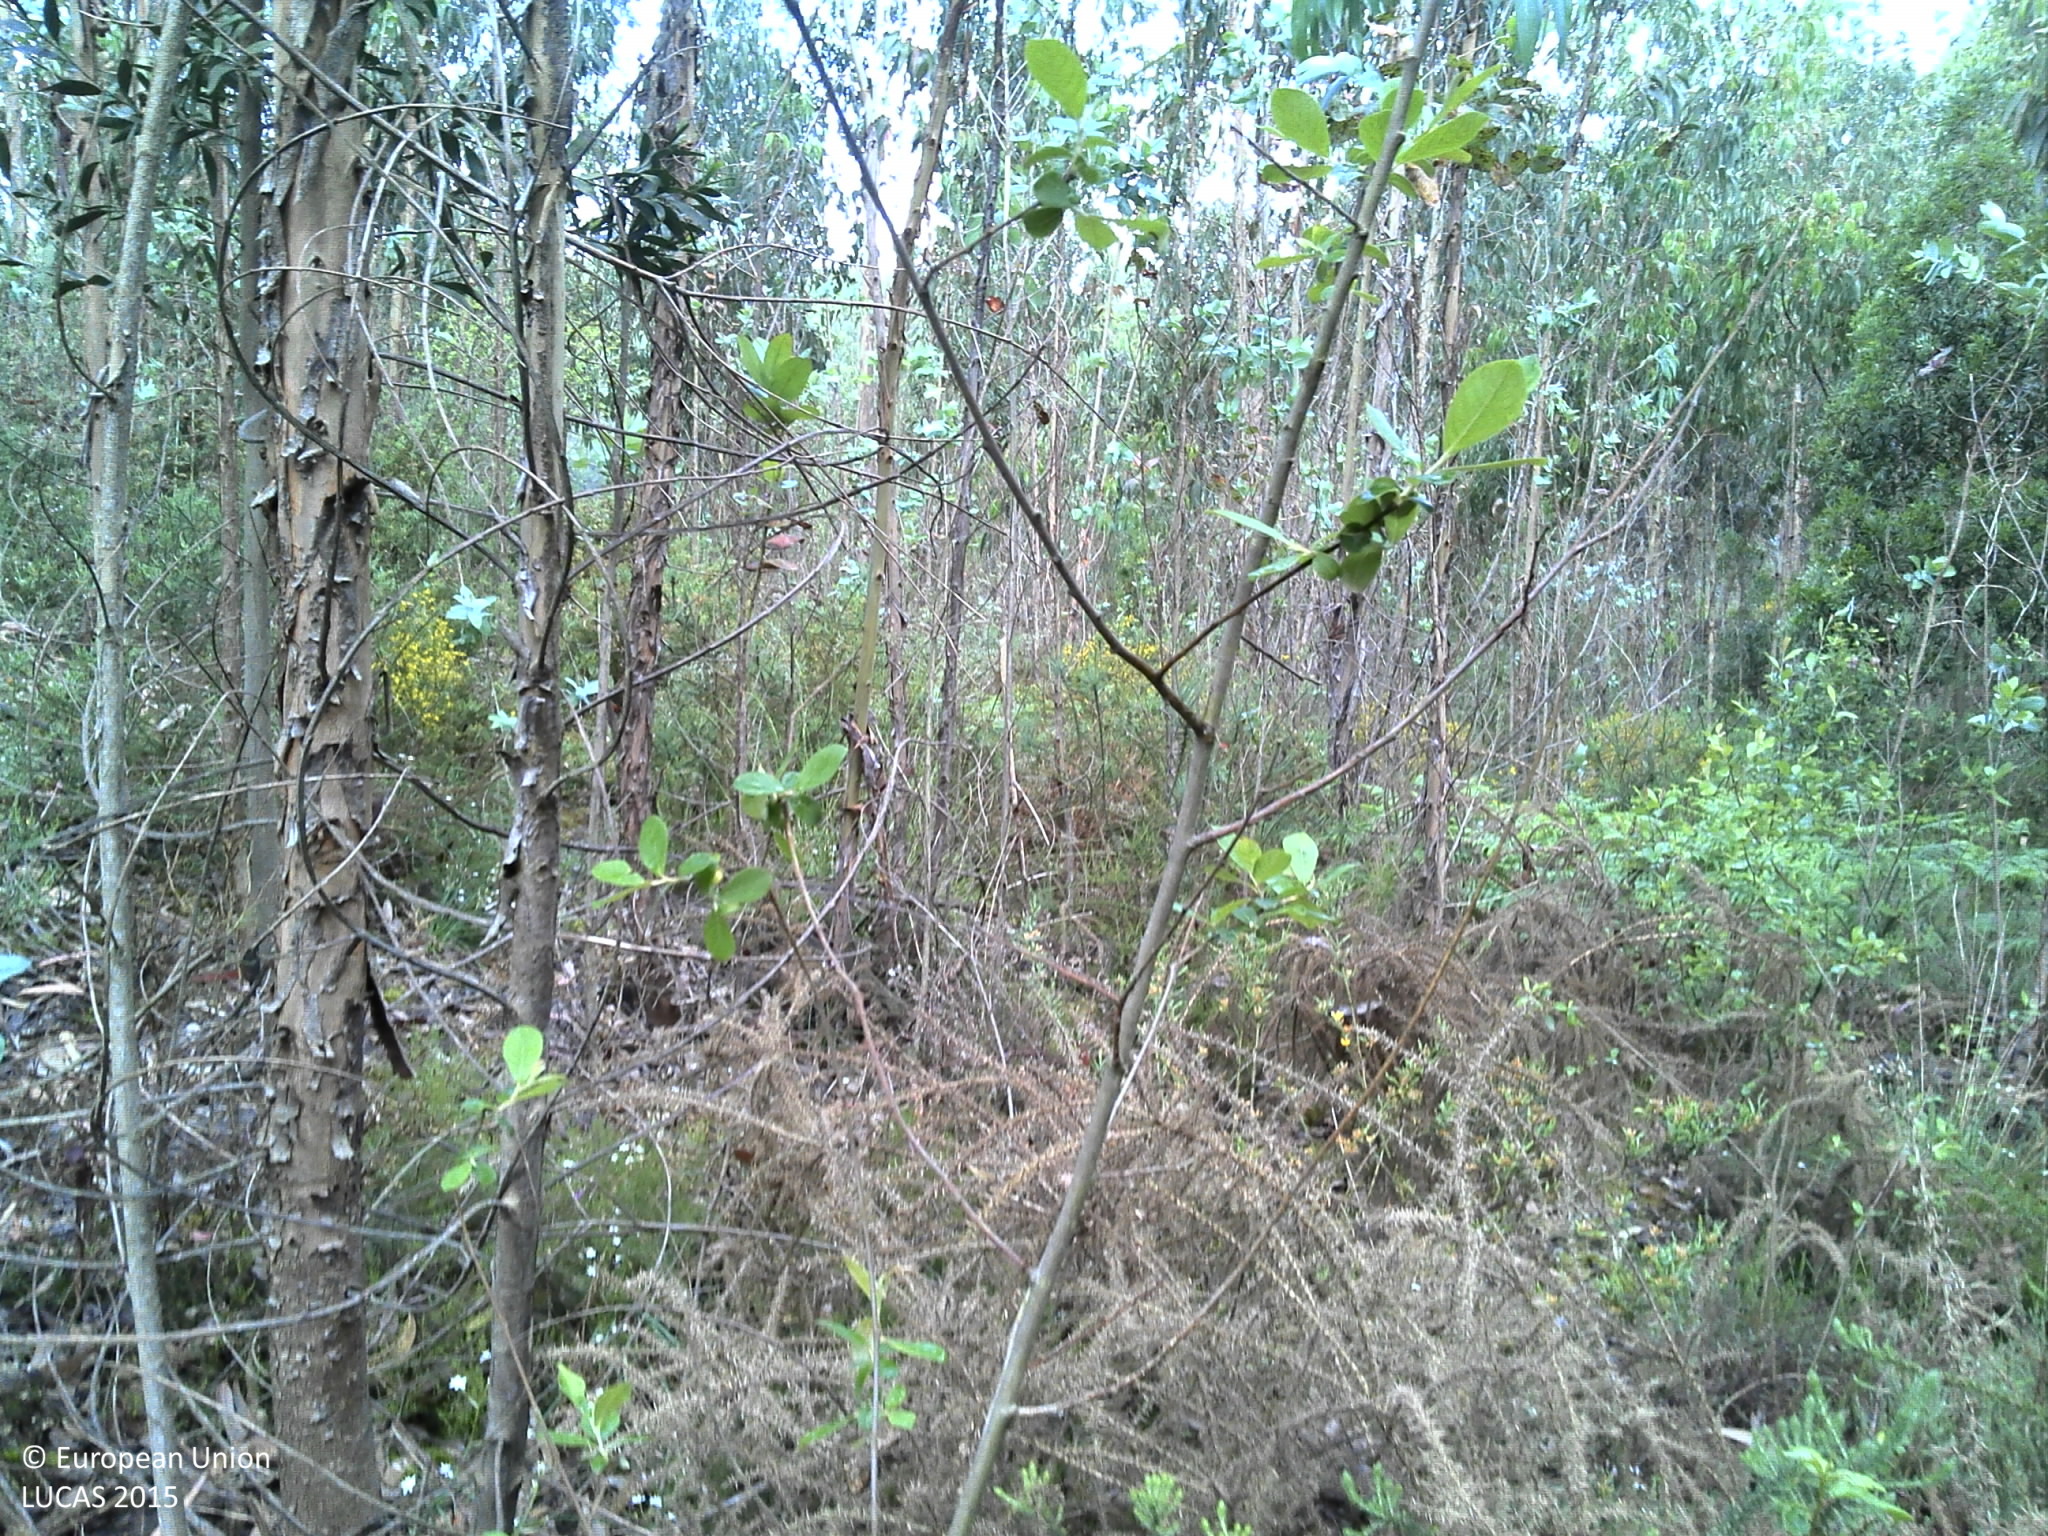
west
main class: Woodland
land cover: Broadleaved woodland
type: exotic forest
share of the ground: 50 - 75 %
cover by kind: broadleaved forest trees 60 %, shrubs 30 %, herbaceous plants 5 %, unconsolidated bare surface 5 %
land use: Forestry
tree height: < 5 m
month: May
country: PT
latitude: 41.2128
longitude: -8.4816
